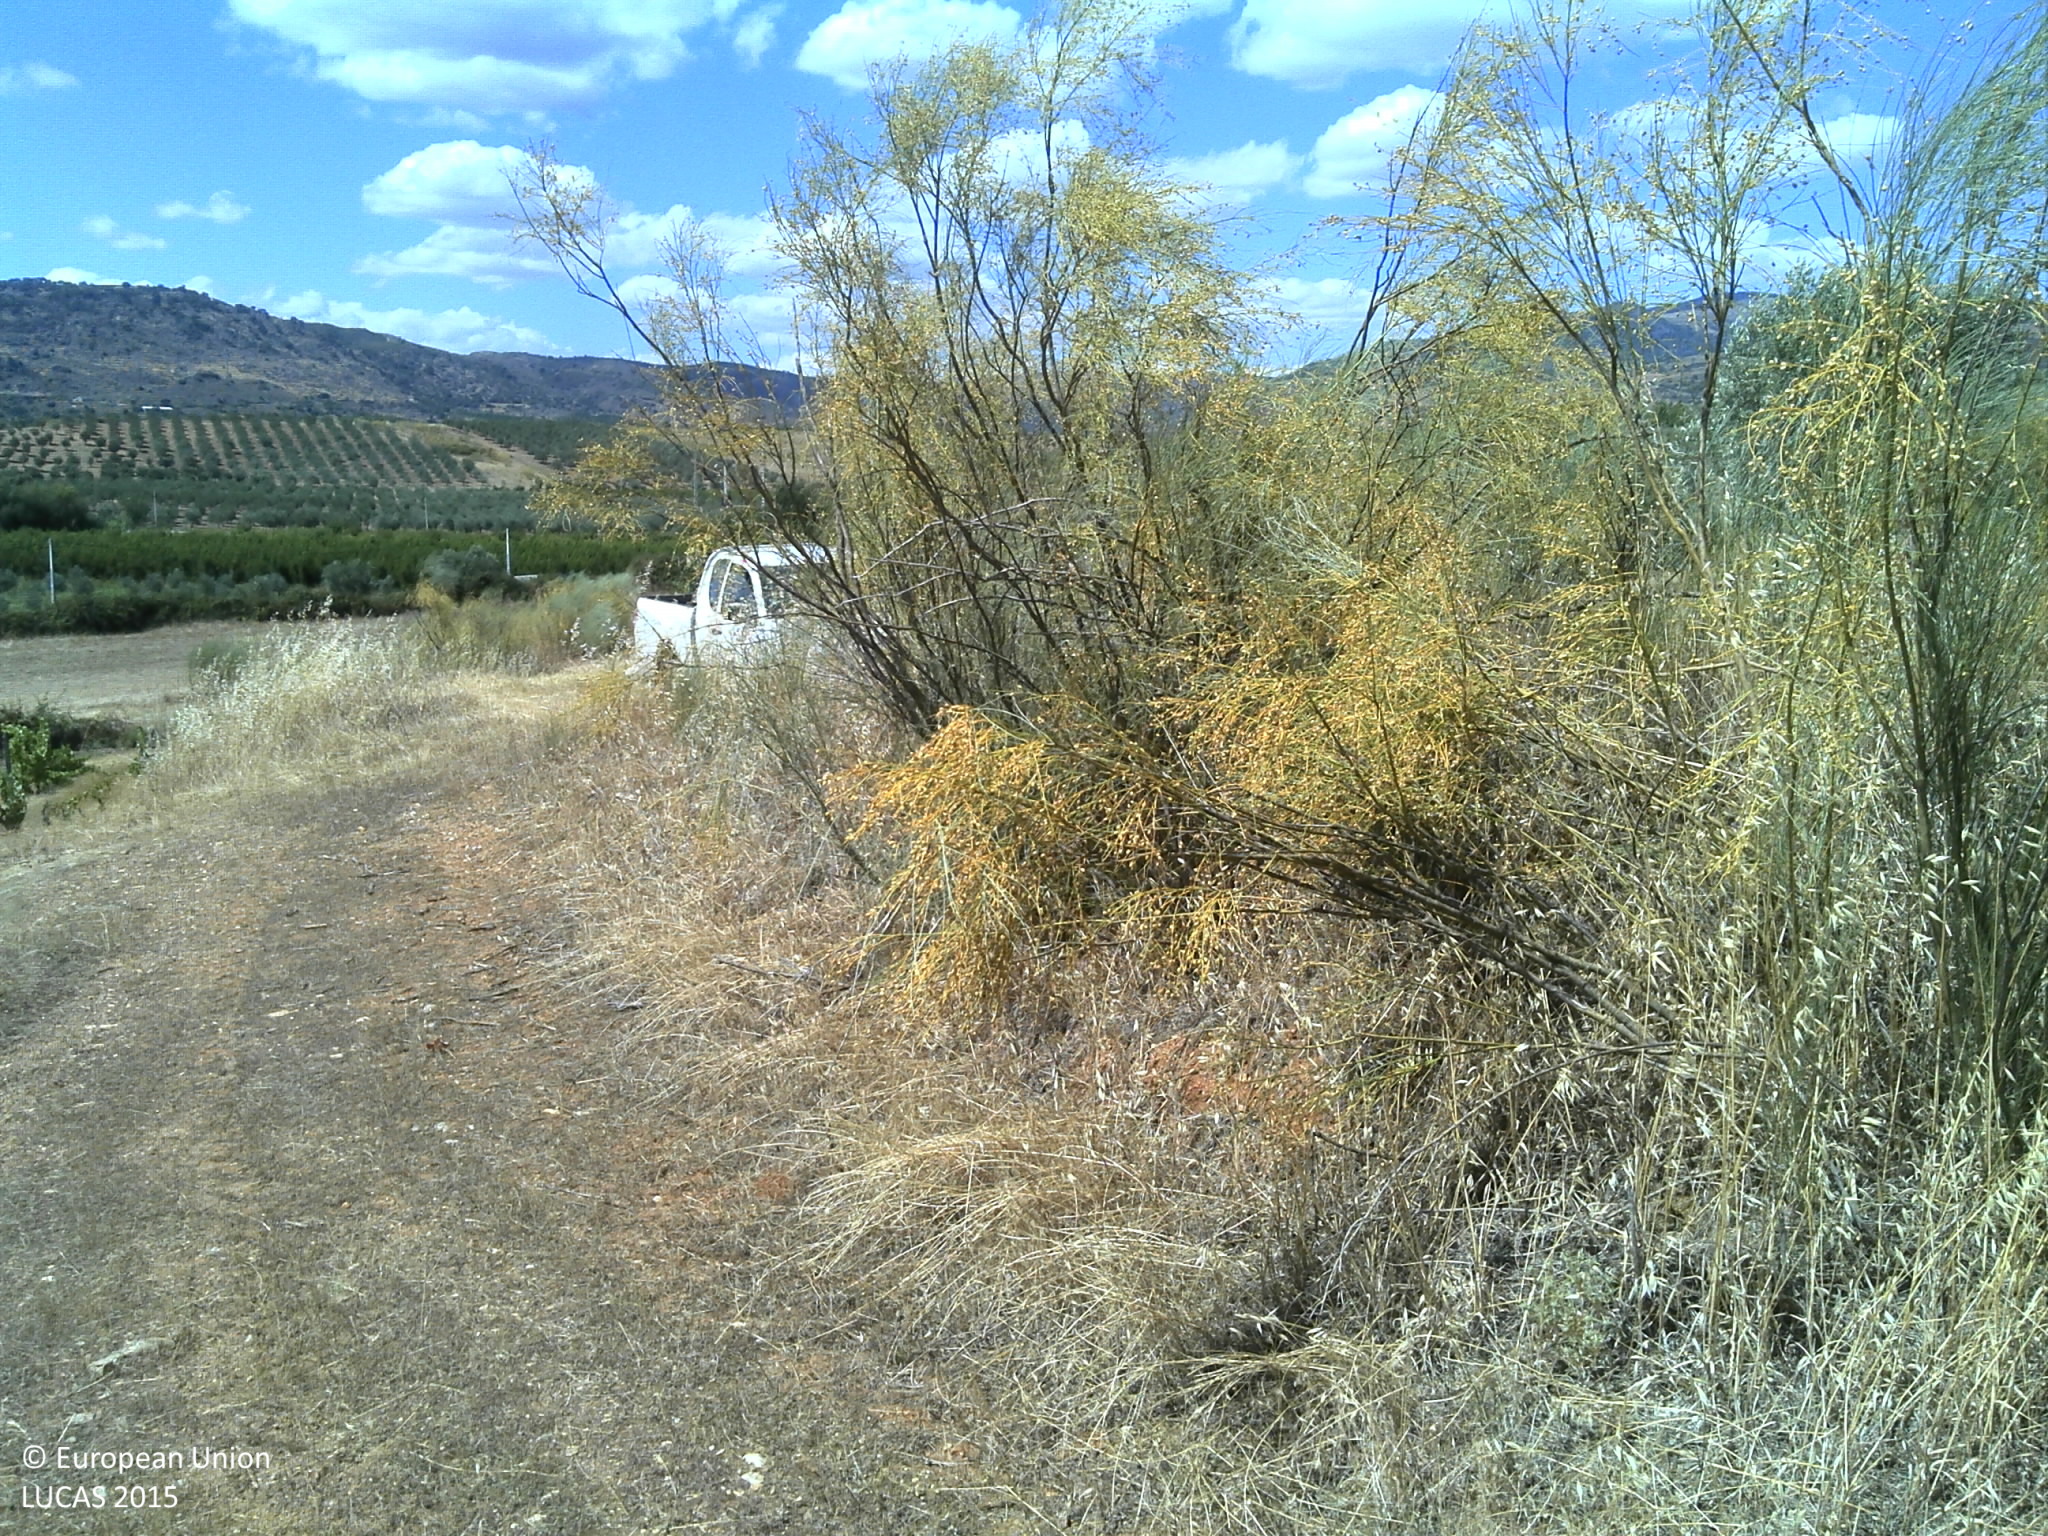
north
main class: Cropland
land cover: Vineyards
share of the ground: < 10 %
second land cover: Spontaneously vegetated surfaces
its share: 25 - 50 %
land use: Agriculture (excluding fallow land and kitchen gardens)
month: July
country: PT
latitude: 41.3436
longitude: -7.0476
